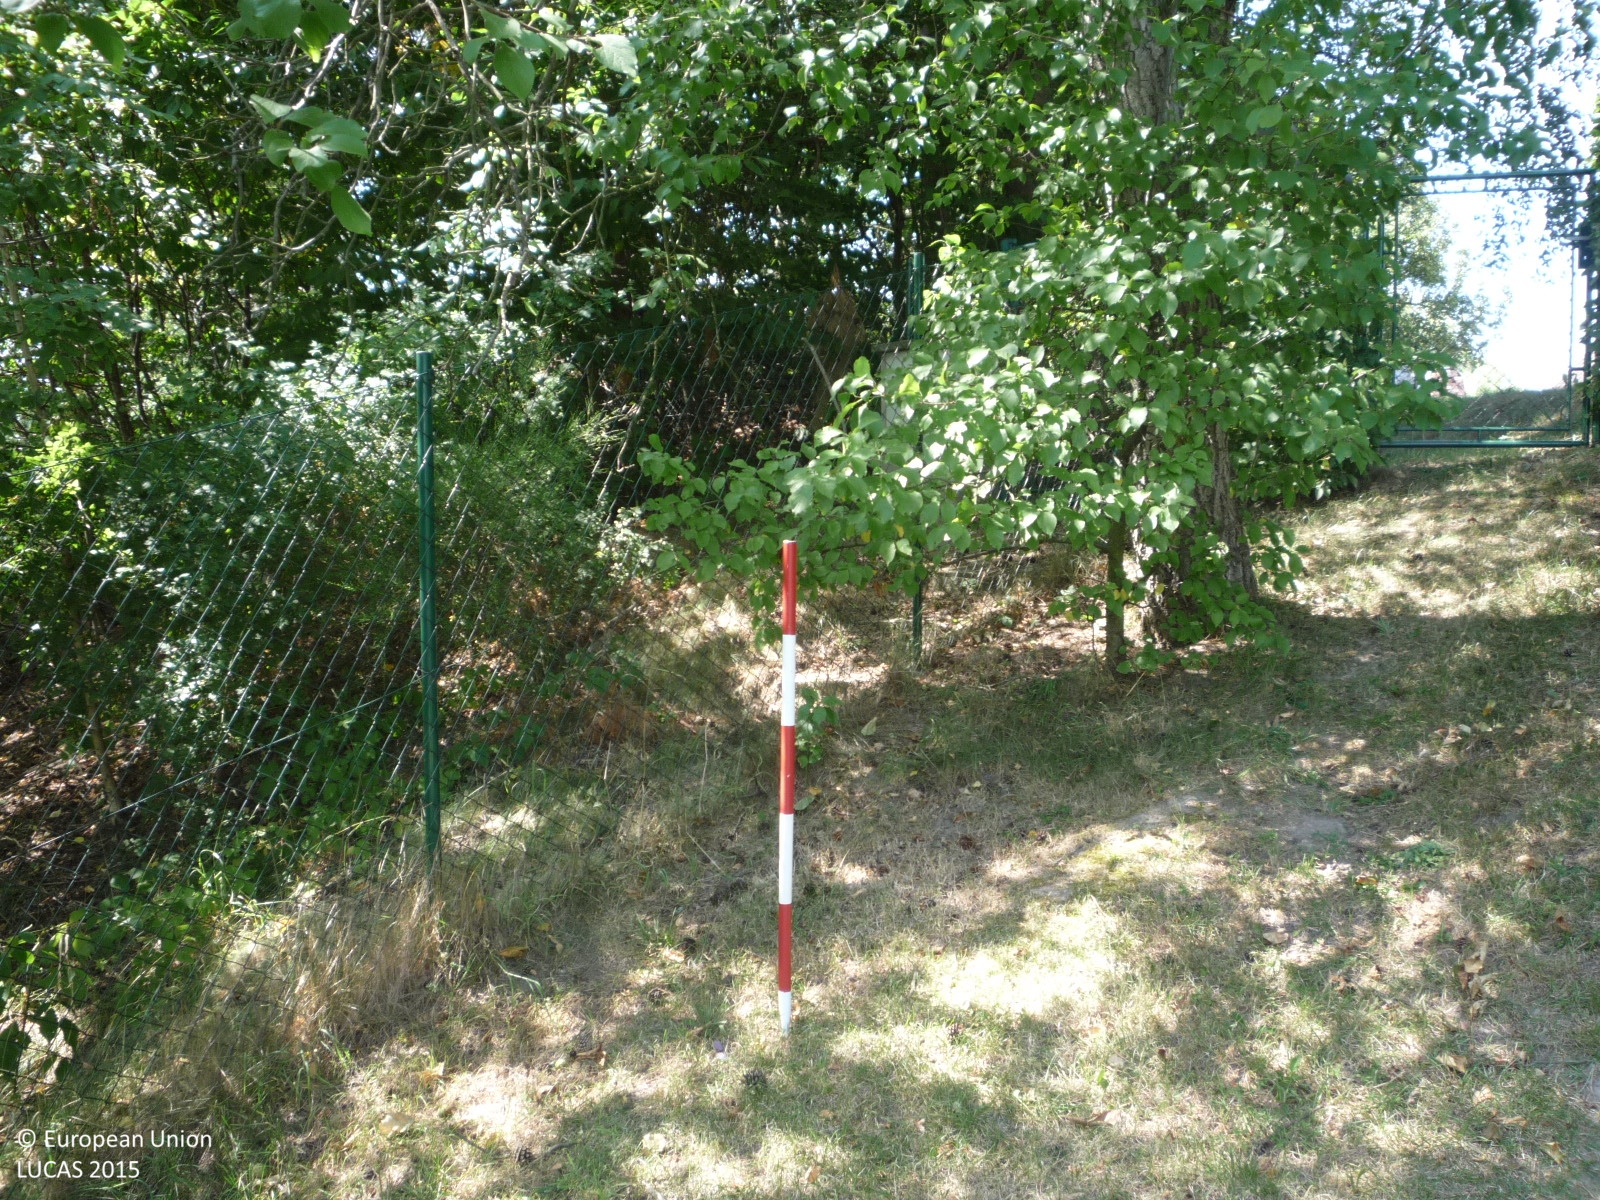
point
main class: Cropland
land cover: Apple fruit
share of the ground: > 75 %
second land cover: Grassland without tree/shrub cover
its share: < 10 %
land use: Kitchen garden
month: August
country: CZ
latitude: 50.5875
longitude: 15.2153
